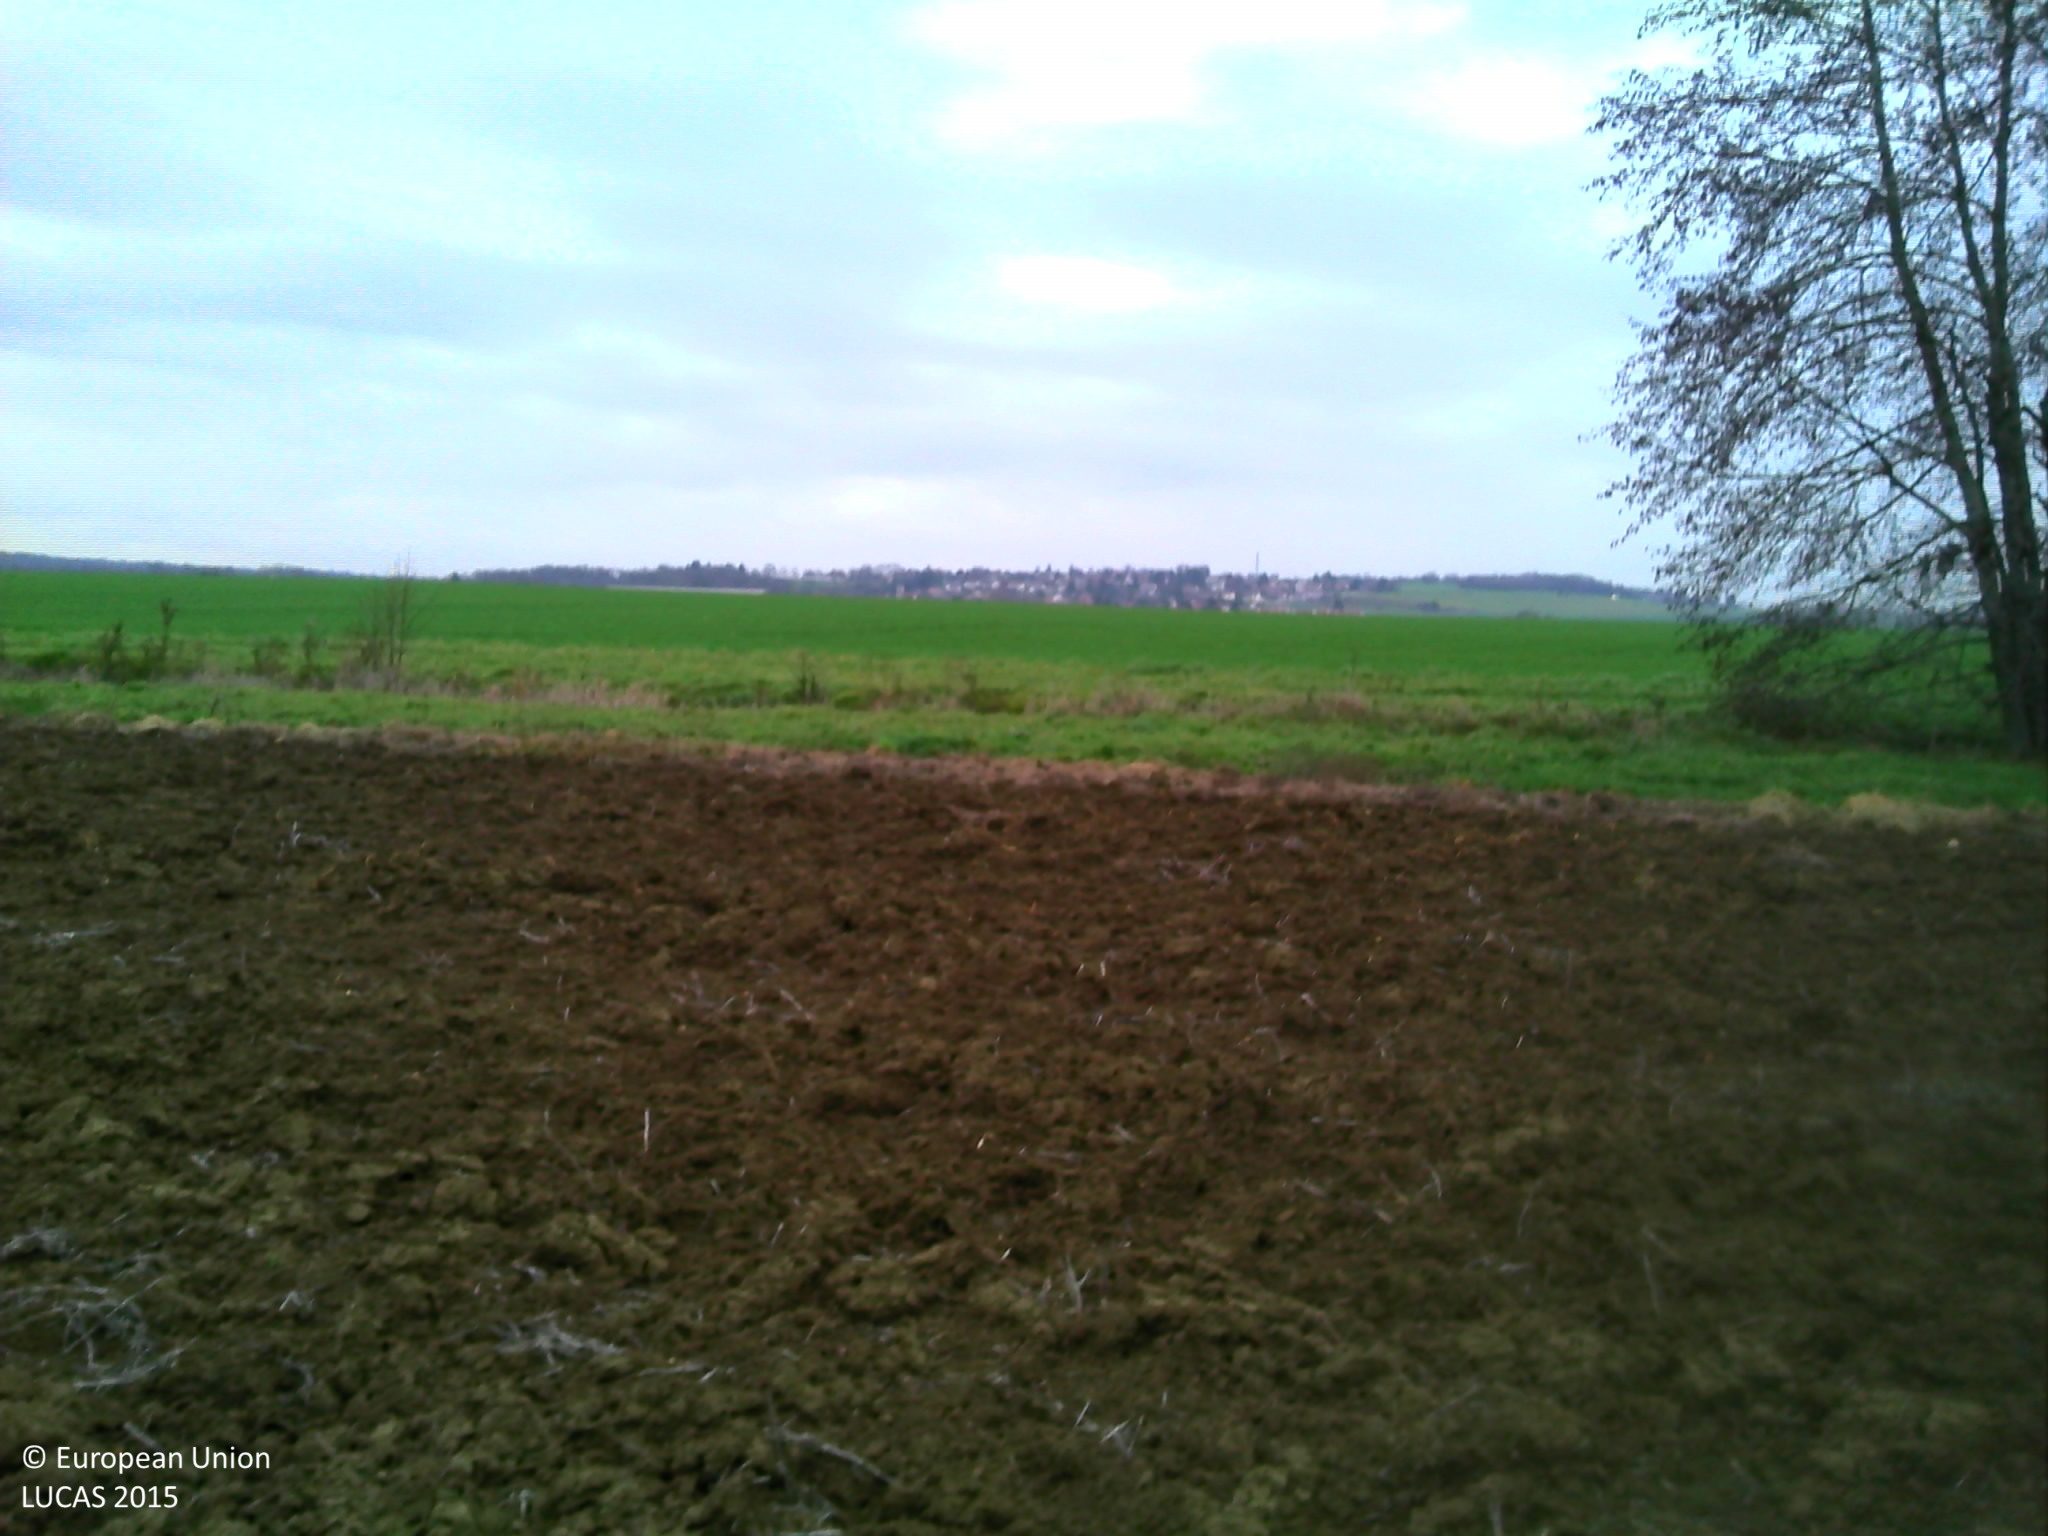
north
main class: Cropland
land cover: Dry pulses
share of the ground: < 10 %
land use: Agriculture (excluding fallow land and kitchen gardens)
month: December
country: FR
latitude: 47.3471
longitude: 5.2752
